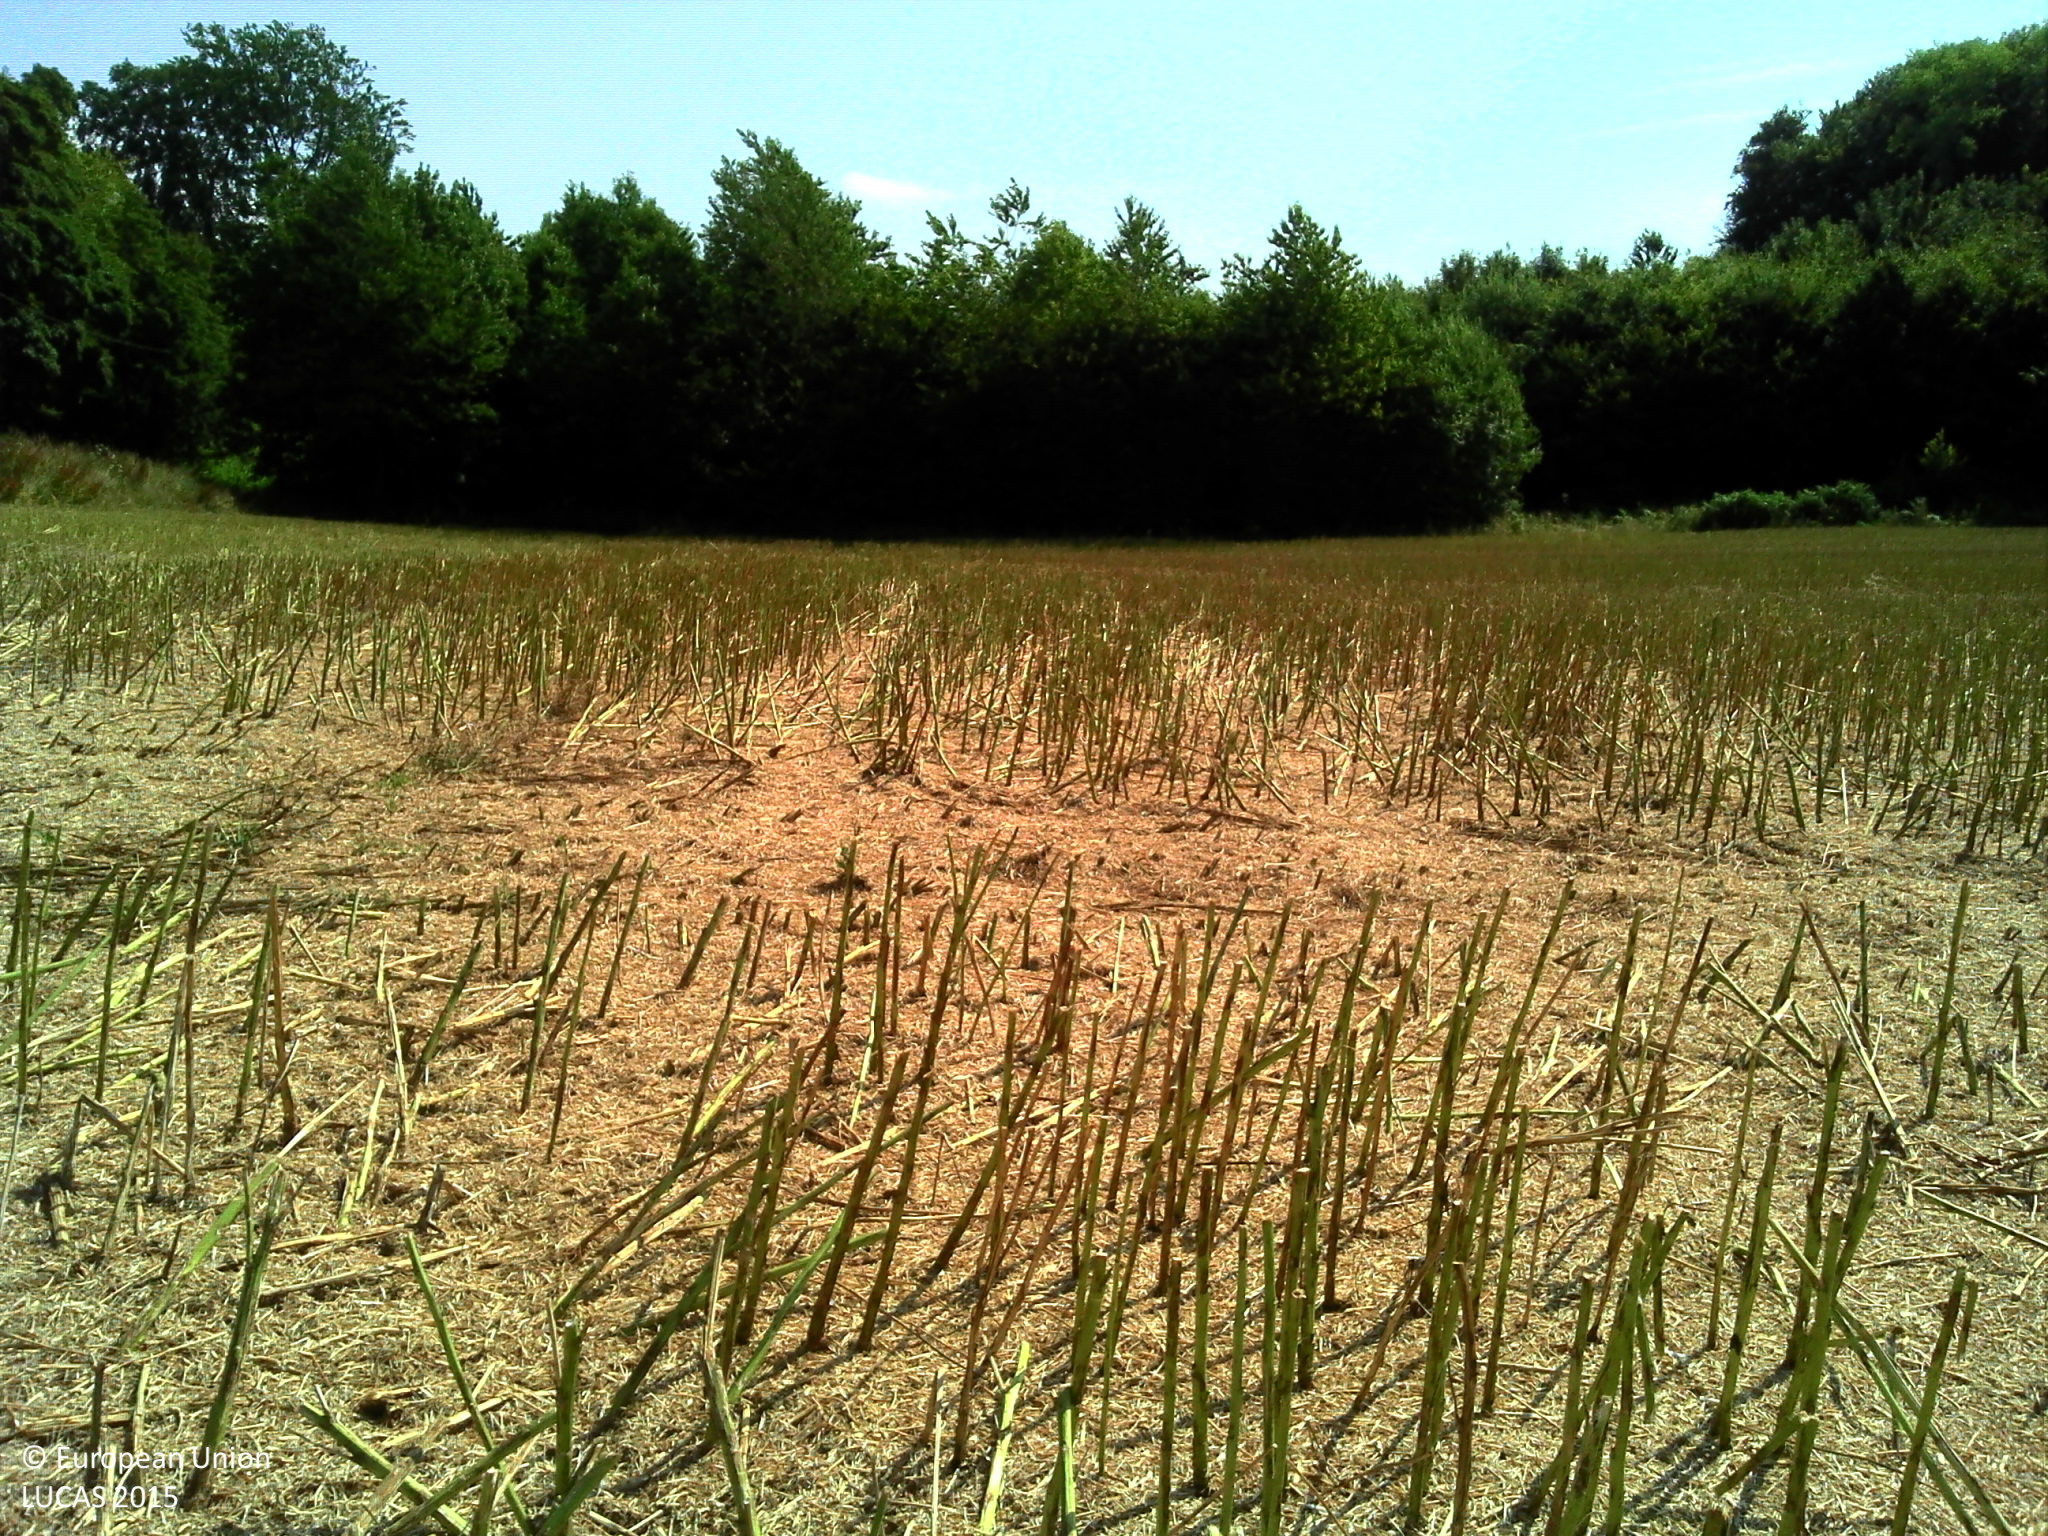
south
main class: Cropland
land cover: Rape and turnip rape
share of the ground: 25 - 50 %
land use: Agriculture (excluding fallow land and kitchen gardens)
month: August
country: FR
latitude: 50.7723
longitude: 2.0293
